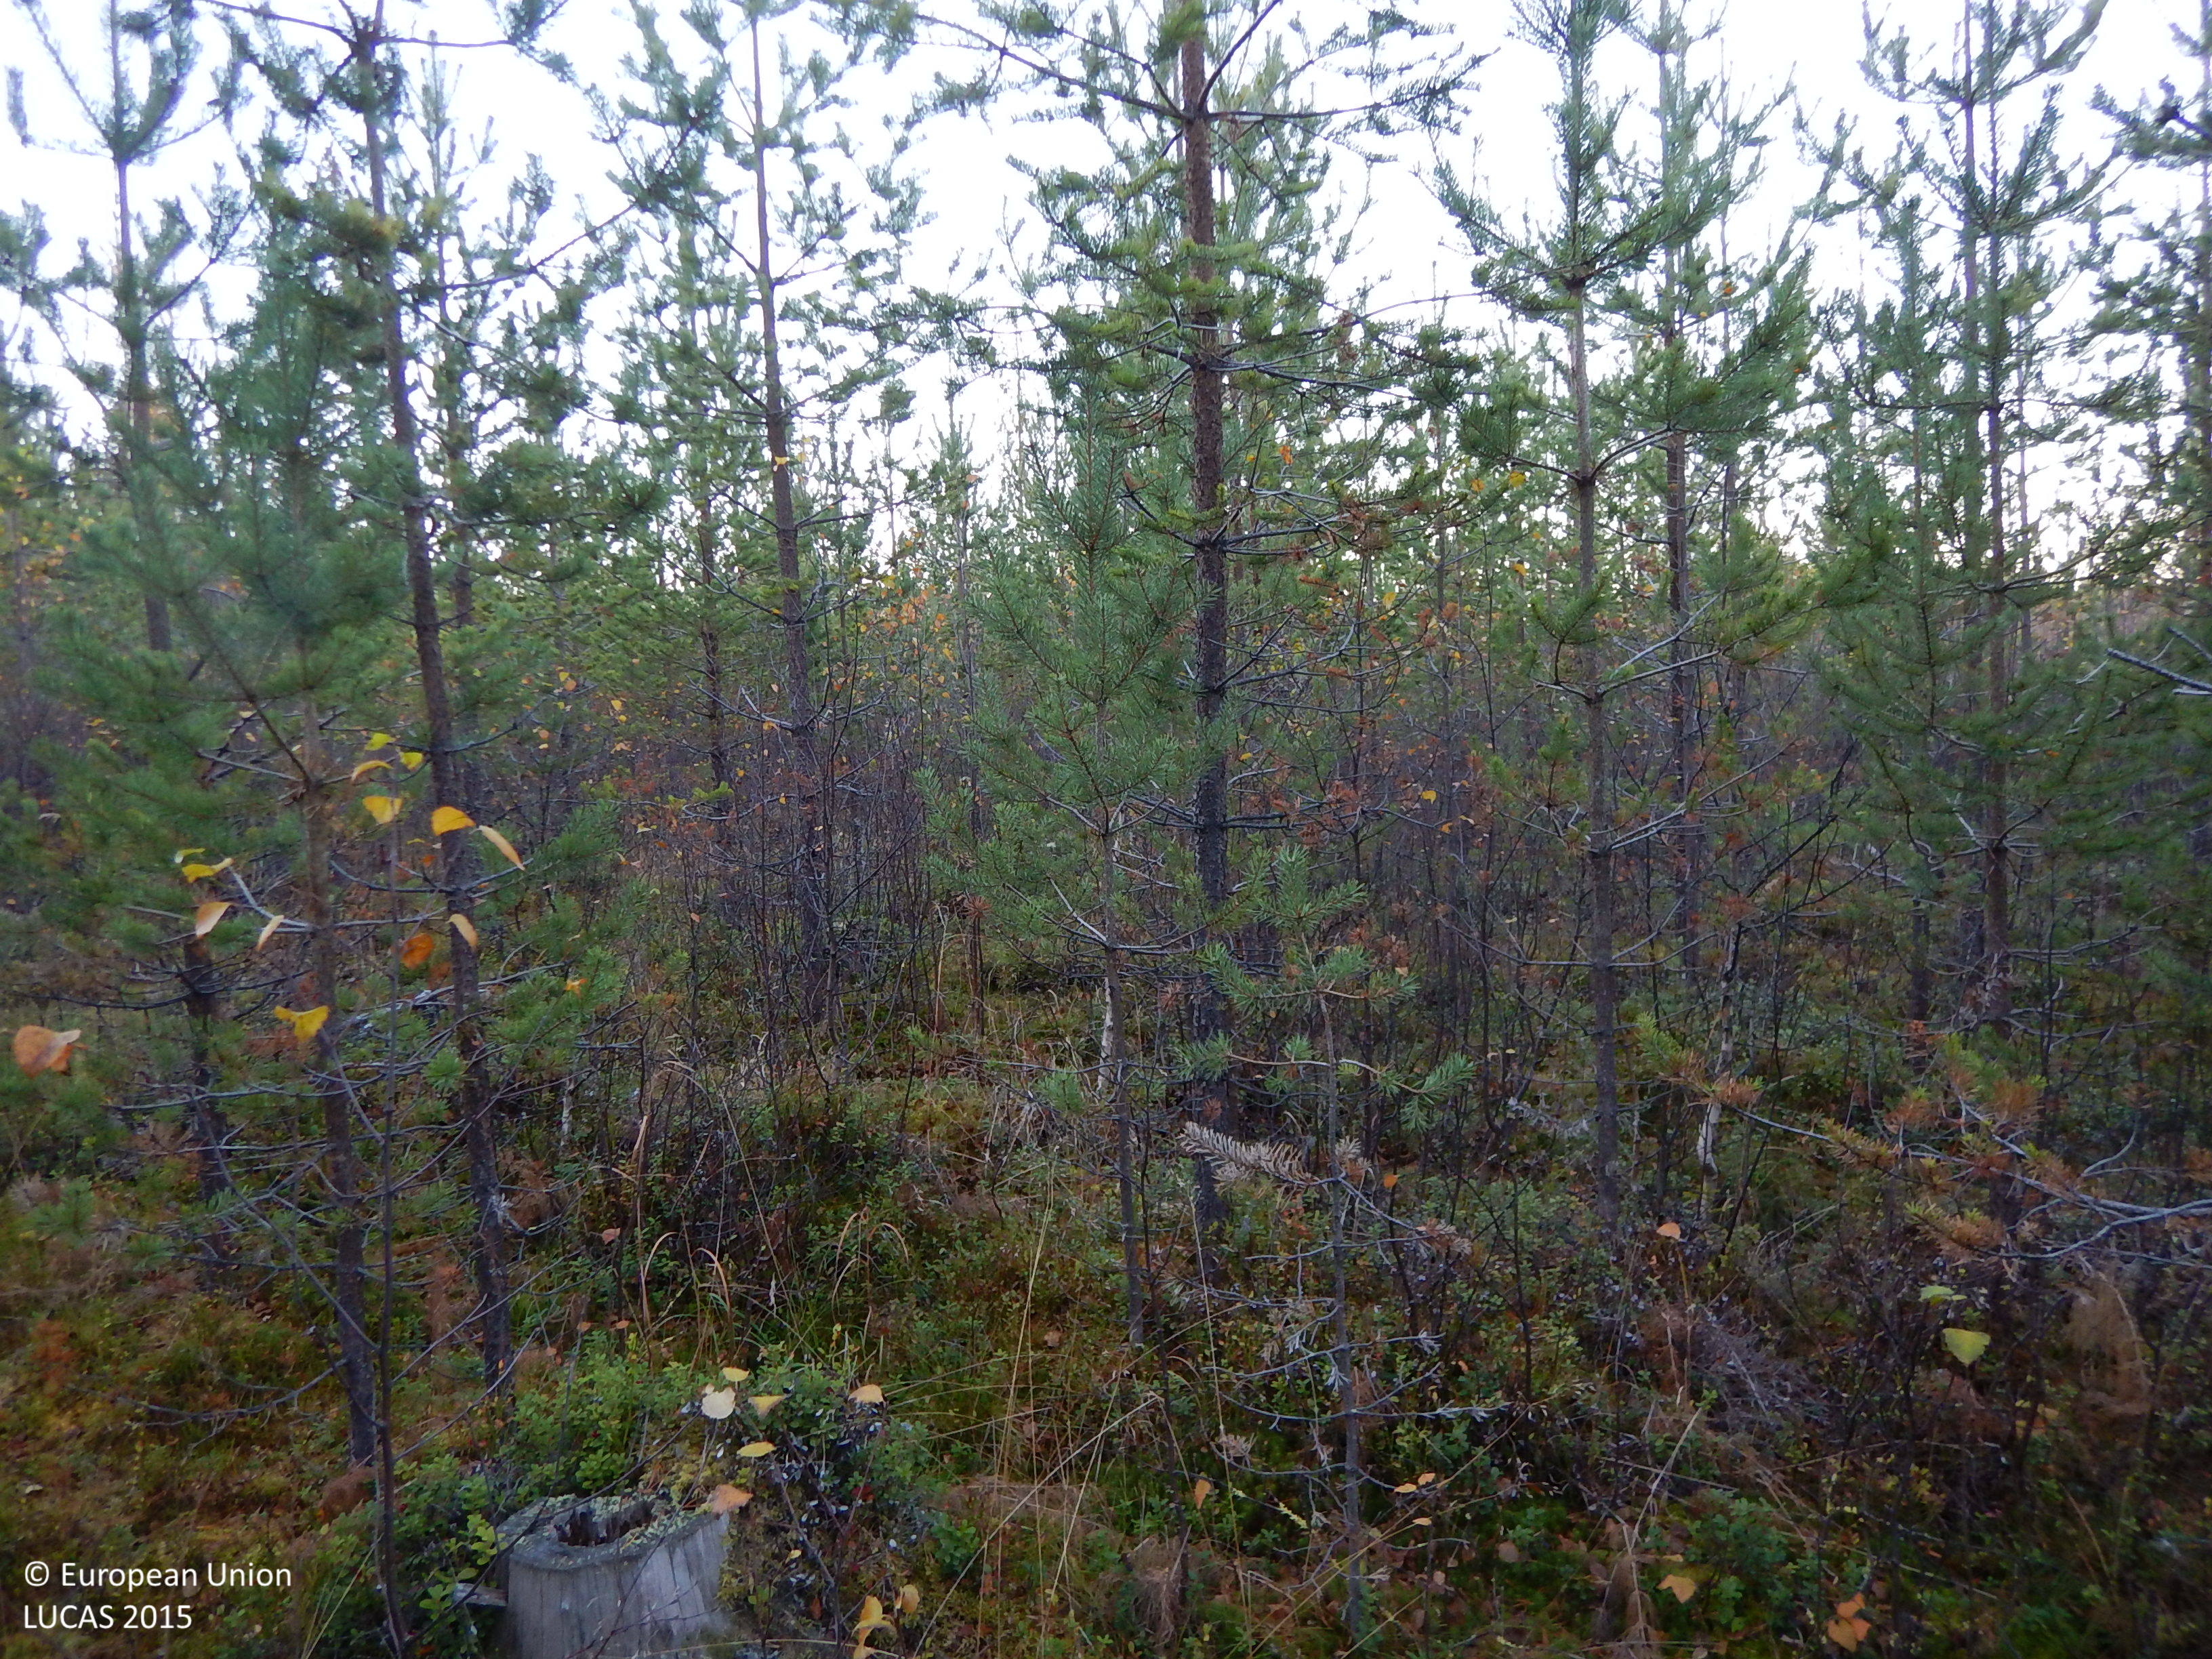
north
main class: Woodland
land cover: Pine dominated mixed woodland
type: boreal forest
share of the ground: 50 - 75 %
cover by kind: coniferous forest trees 50 %, broadleaved forest trees 20 %, shrubs 10 %, herbaceous plants 10 %, lichens and mosses 10 %
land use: Forestry
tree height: < 5 m
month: October
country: SE
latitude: 64.9466
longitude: 21.0030
